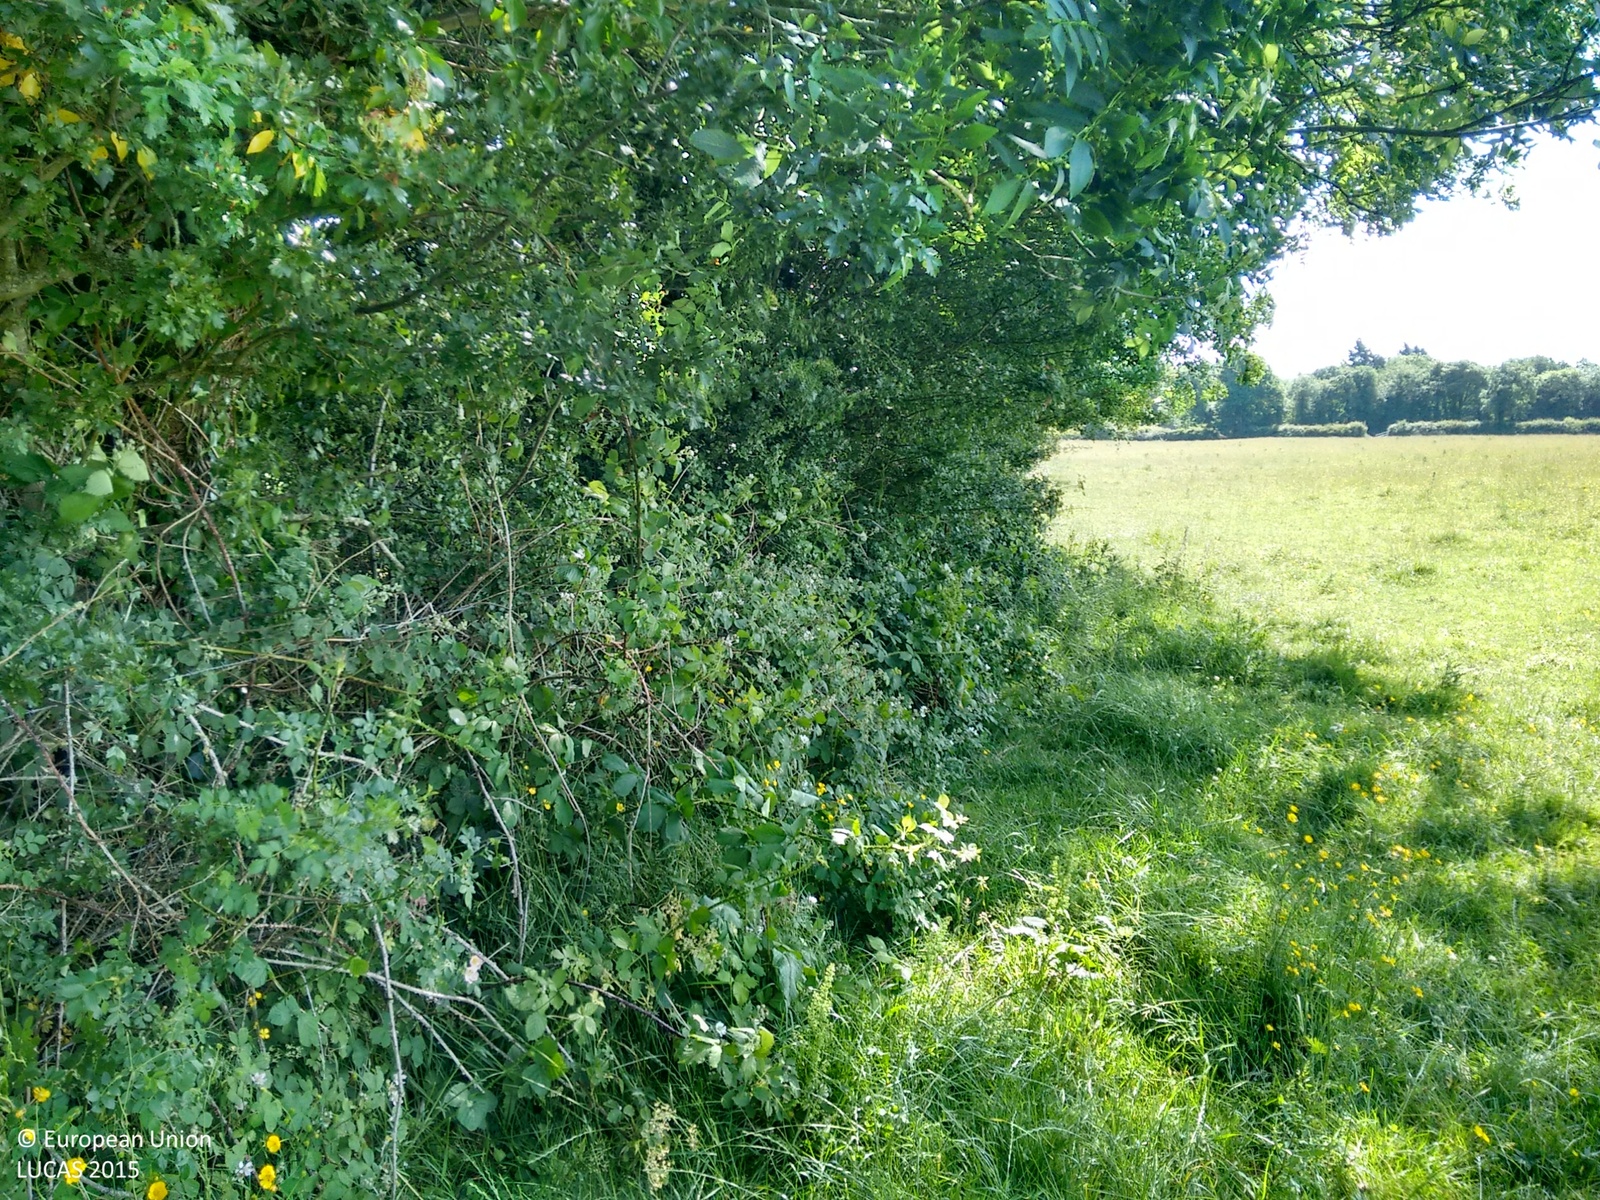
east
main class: Grassland
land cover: Grassland without tree/shrub cover
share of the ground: > 75 %
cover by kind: herbaceous plants 100 %
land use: Agriculture (excluding fallow land and kitchen gardens)
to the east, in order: Grassland without tree/shrub cover; Managed hedges; Grassland without tree/shrub cover; Managed hedges; Paved roads, cycling and walking lanes; Managed hedges; Grassland without tree/shrub cover; Managed hedges; Railways; Grass margins; Managed hedges; Grass margins; Paved roads, cycling and walking lanes
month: June
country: IE
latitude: 53.6639
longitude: -6.7041
